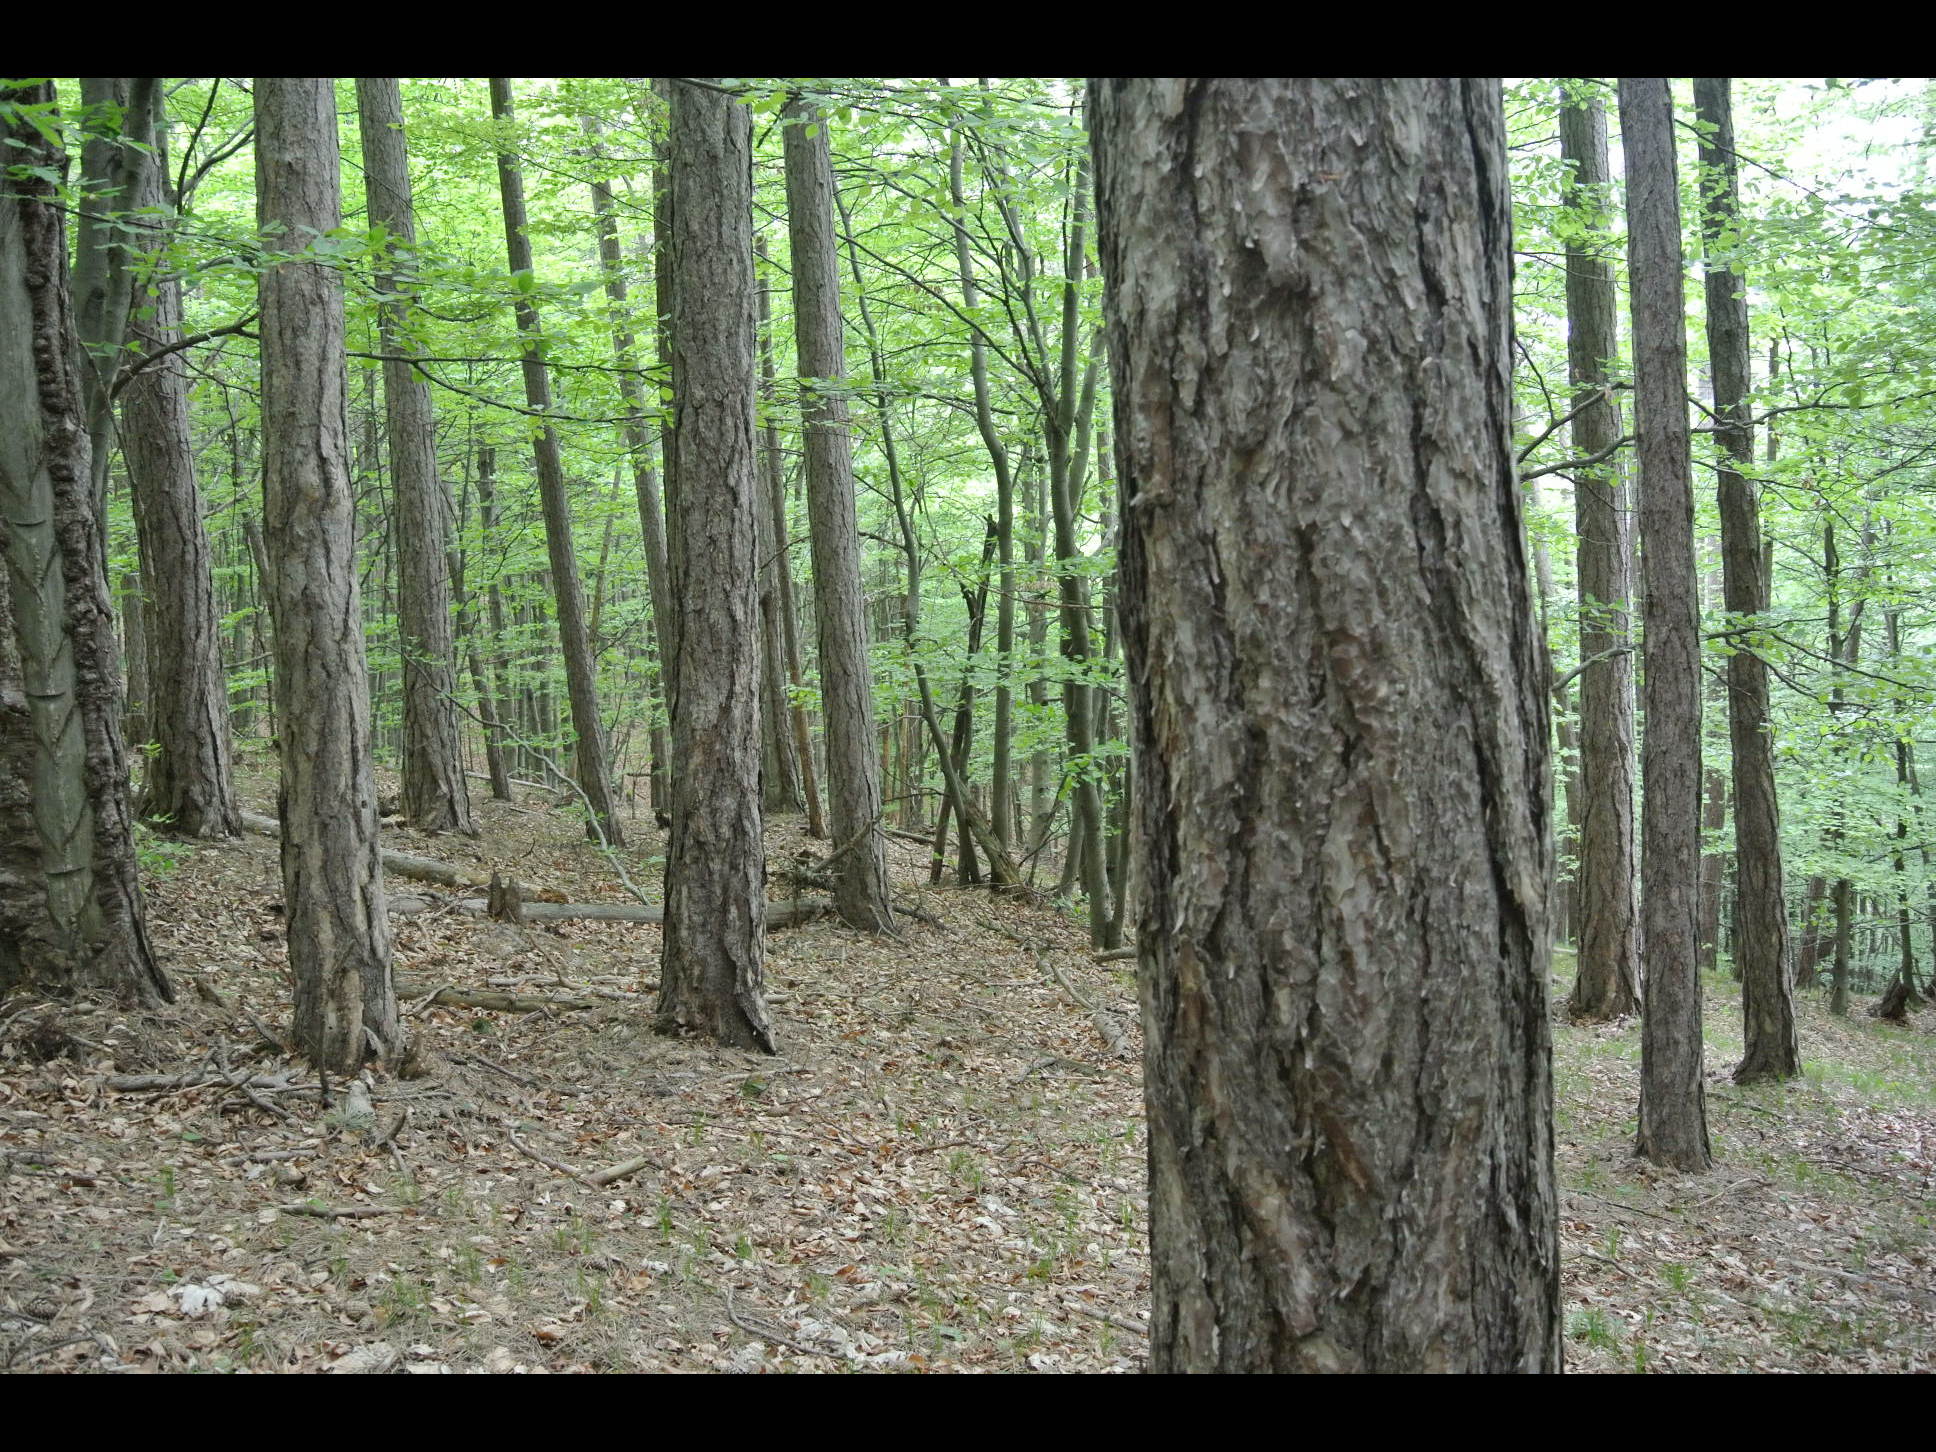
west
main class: Woodland
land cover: Pine dominated mixed woodland
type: alpine coniferous forest
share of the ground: > 75 %
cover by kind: coniferous forest trees 50 %, broadleaved forest trees 50 %
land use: Forestry
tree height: > 5 m
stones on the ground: < 10 %
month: May
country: AT
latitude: 47.9675
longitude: 16.0442
